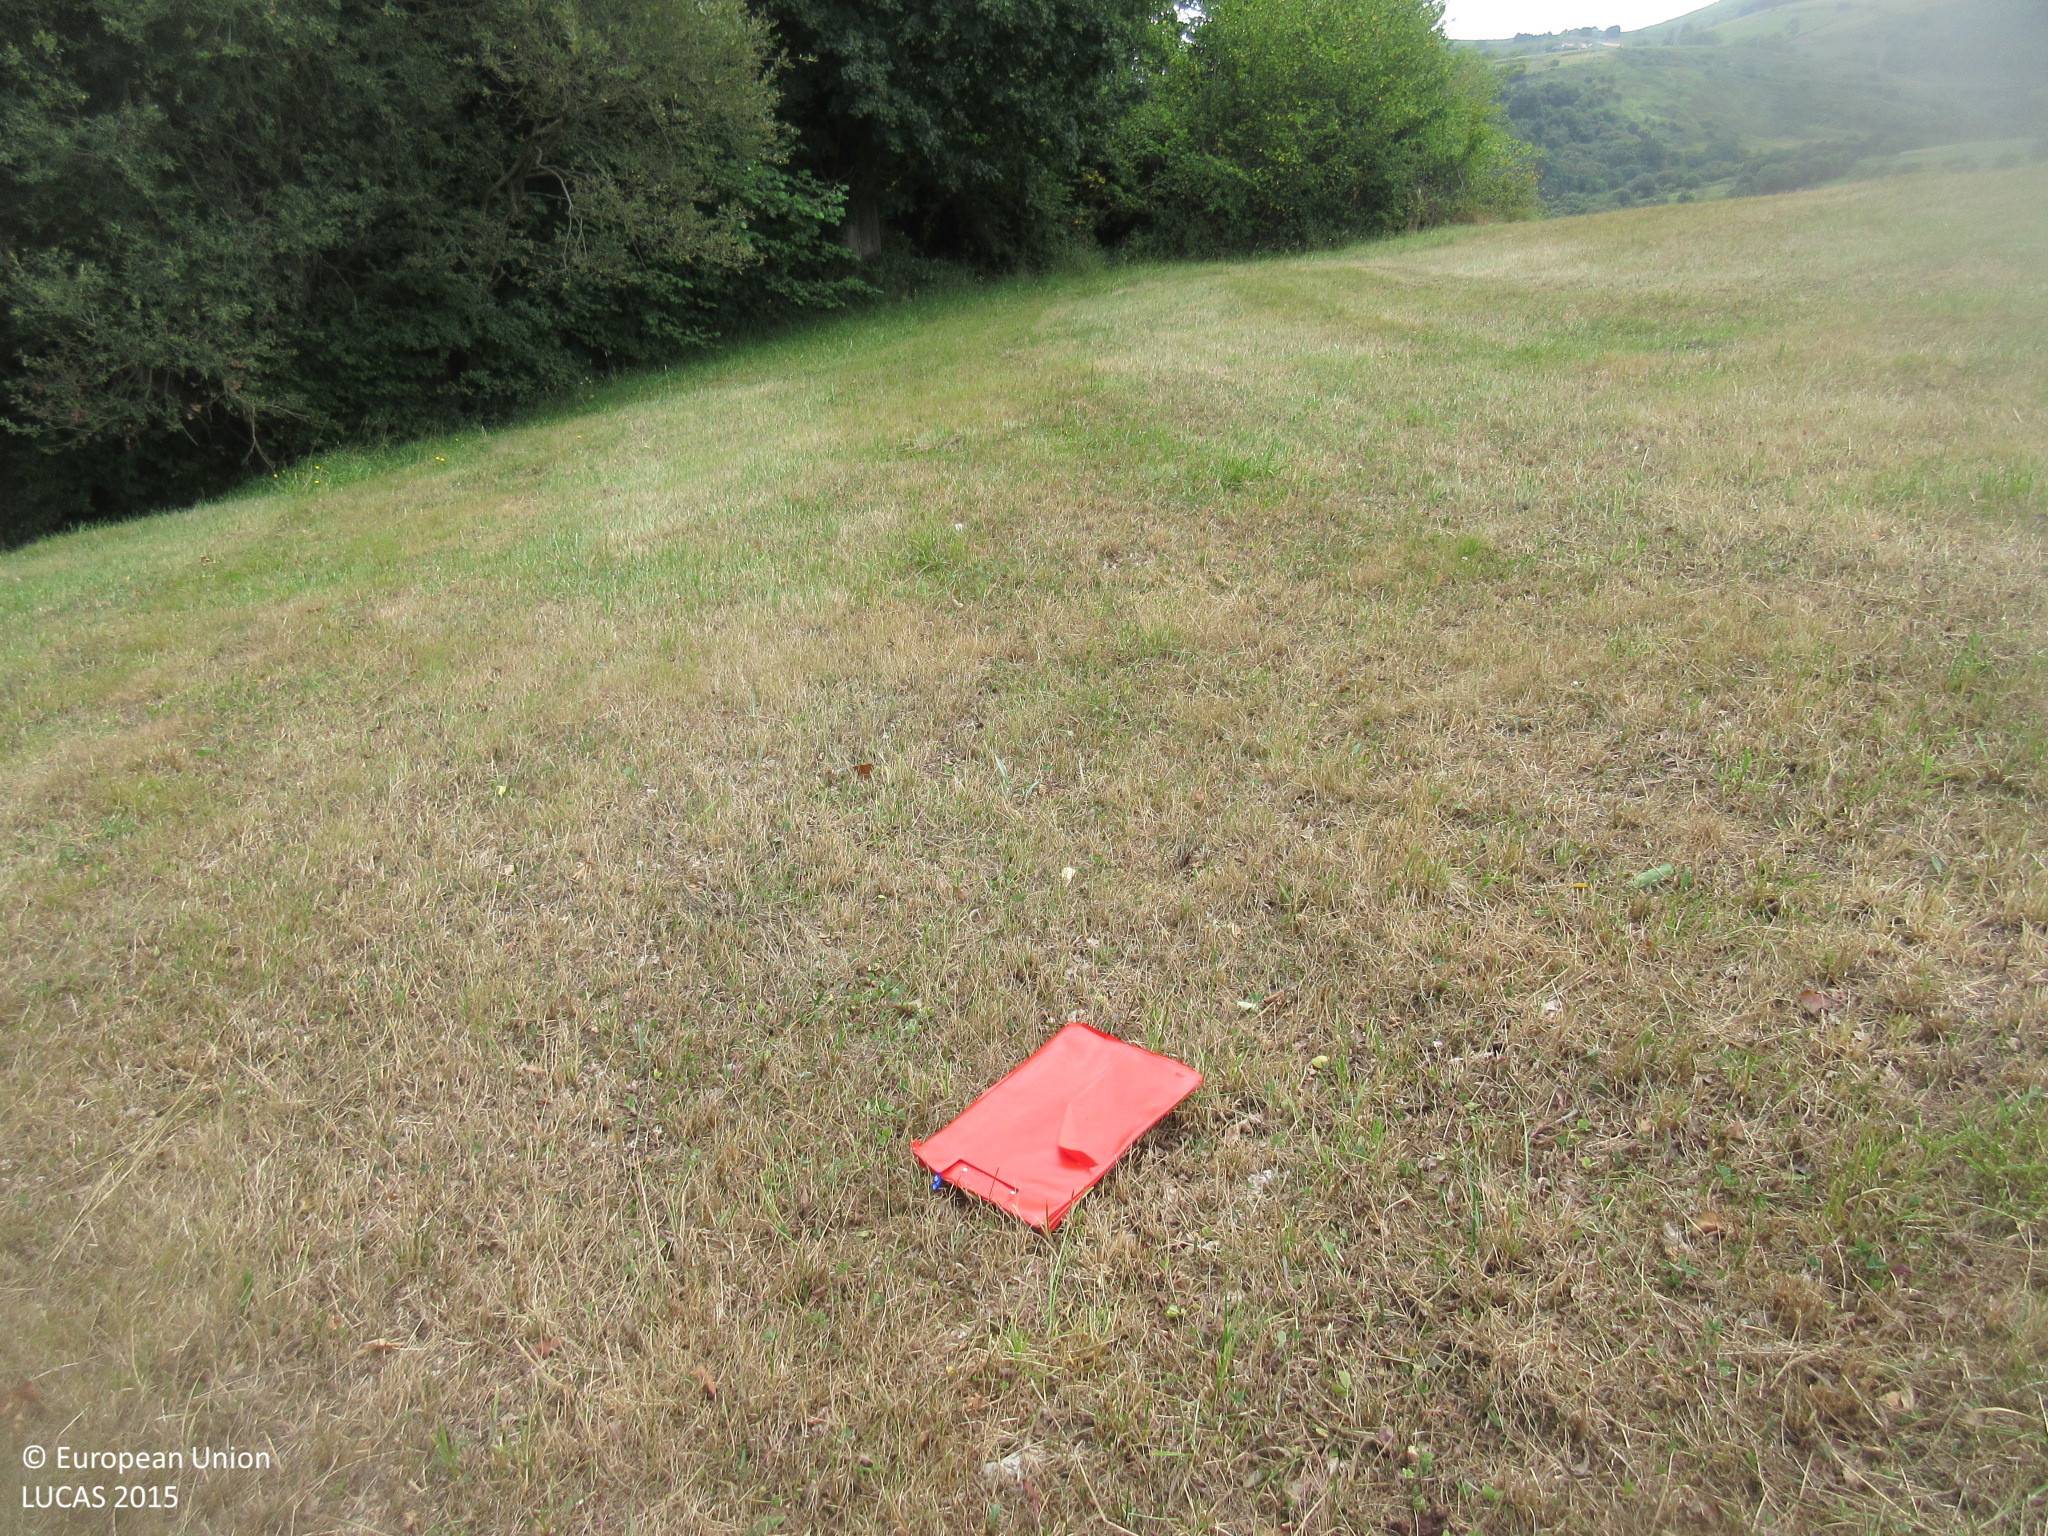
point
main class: Grassland
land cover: Grassland without tree/shrub cover
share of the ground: > 75 %
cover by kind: herbaceous plants 100 %
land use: Agriculture (excluding fallow land and kitchen gardens)
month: July
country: ES
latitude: 43.3360
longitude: -4.4279
